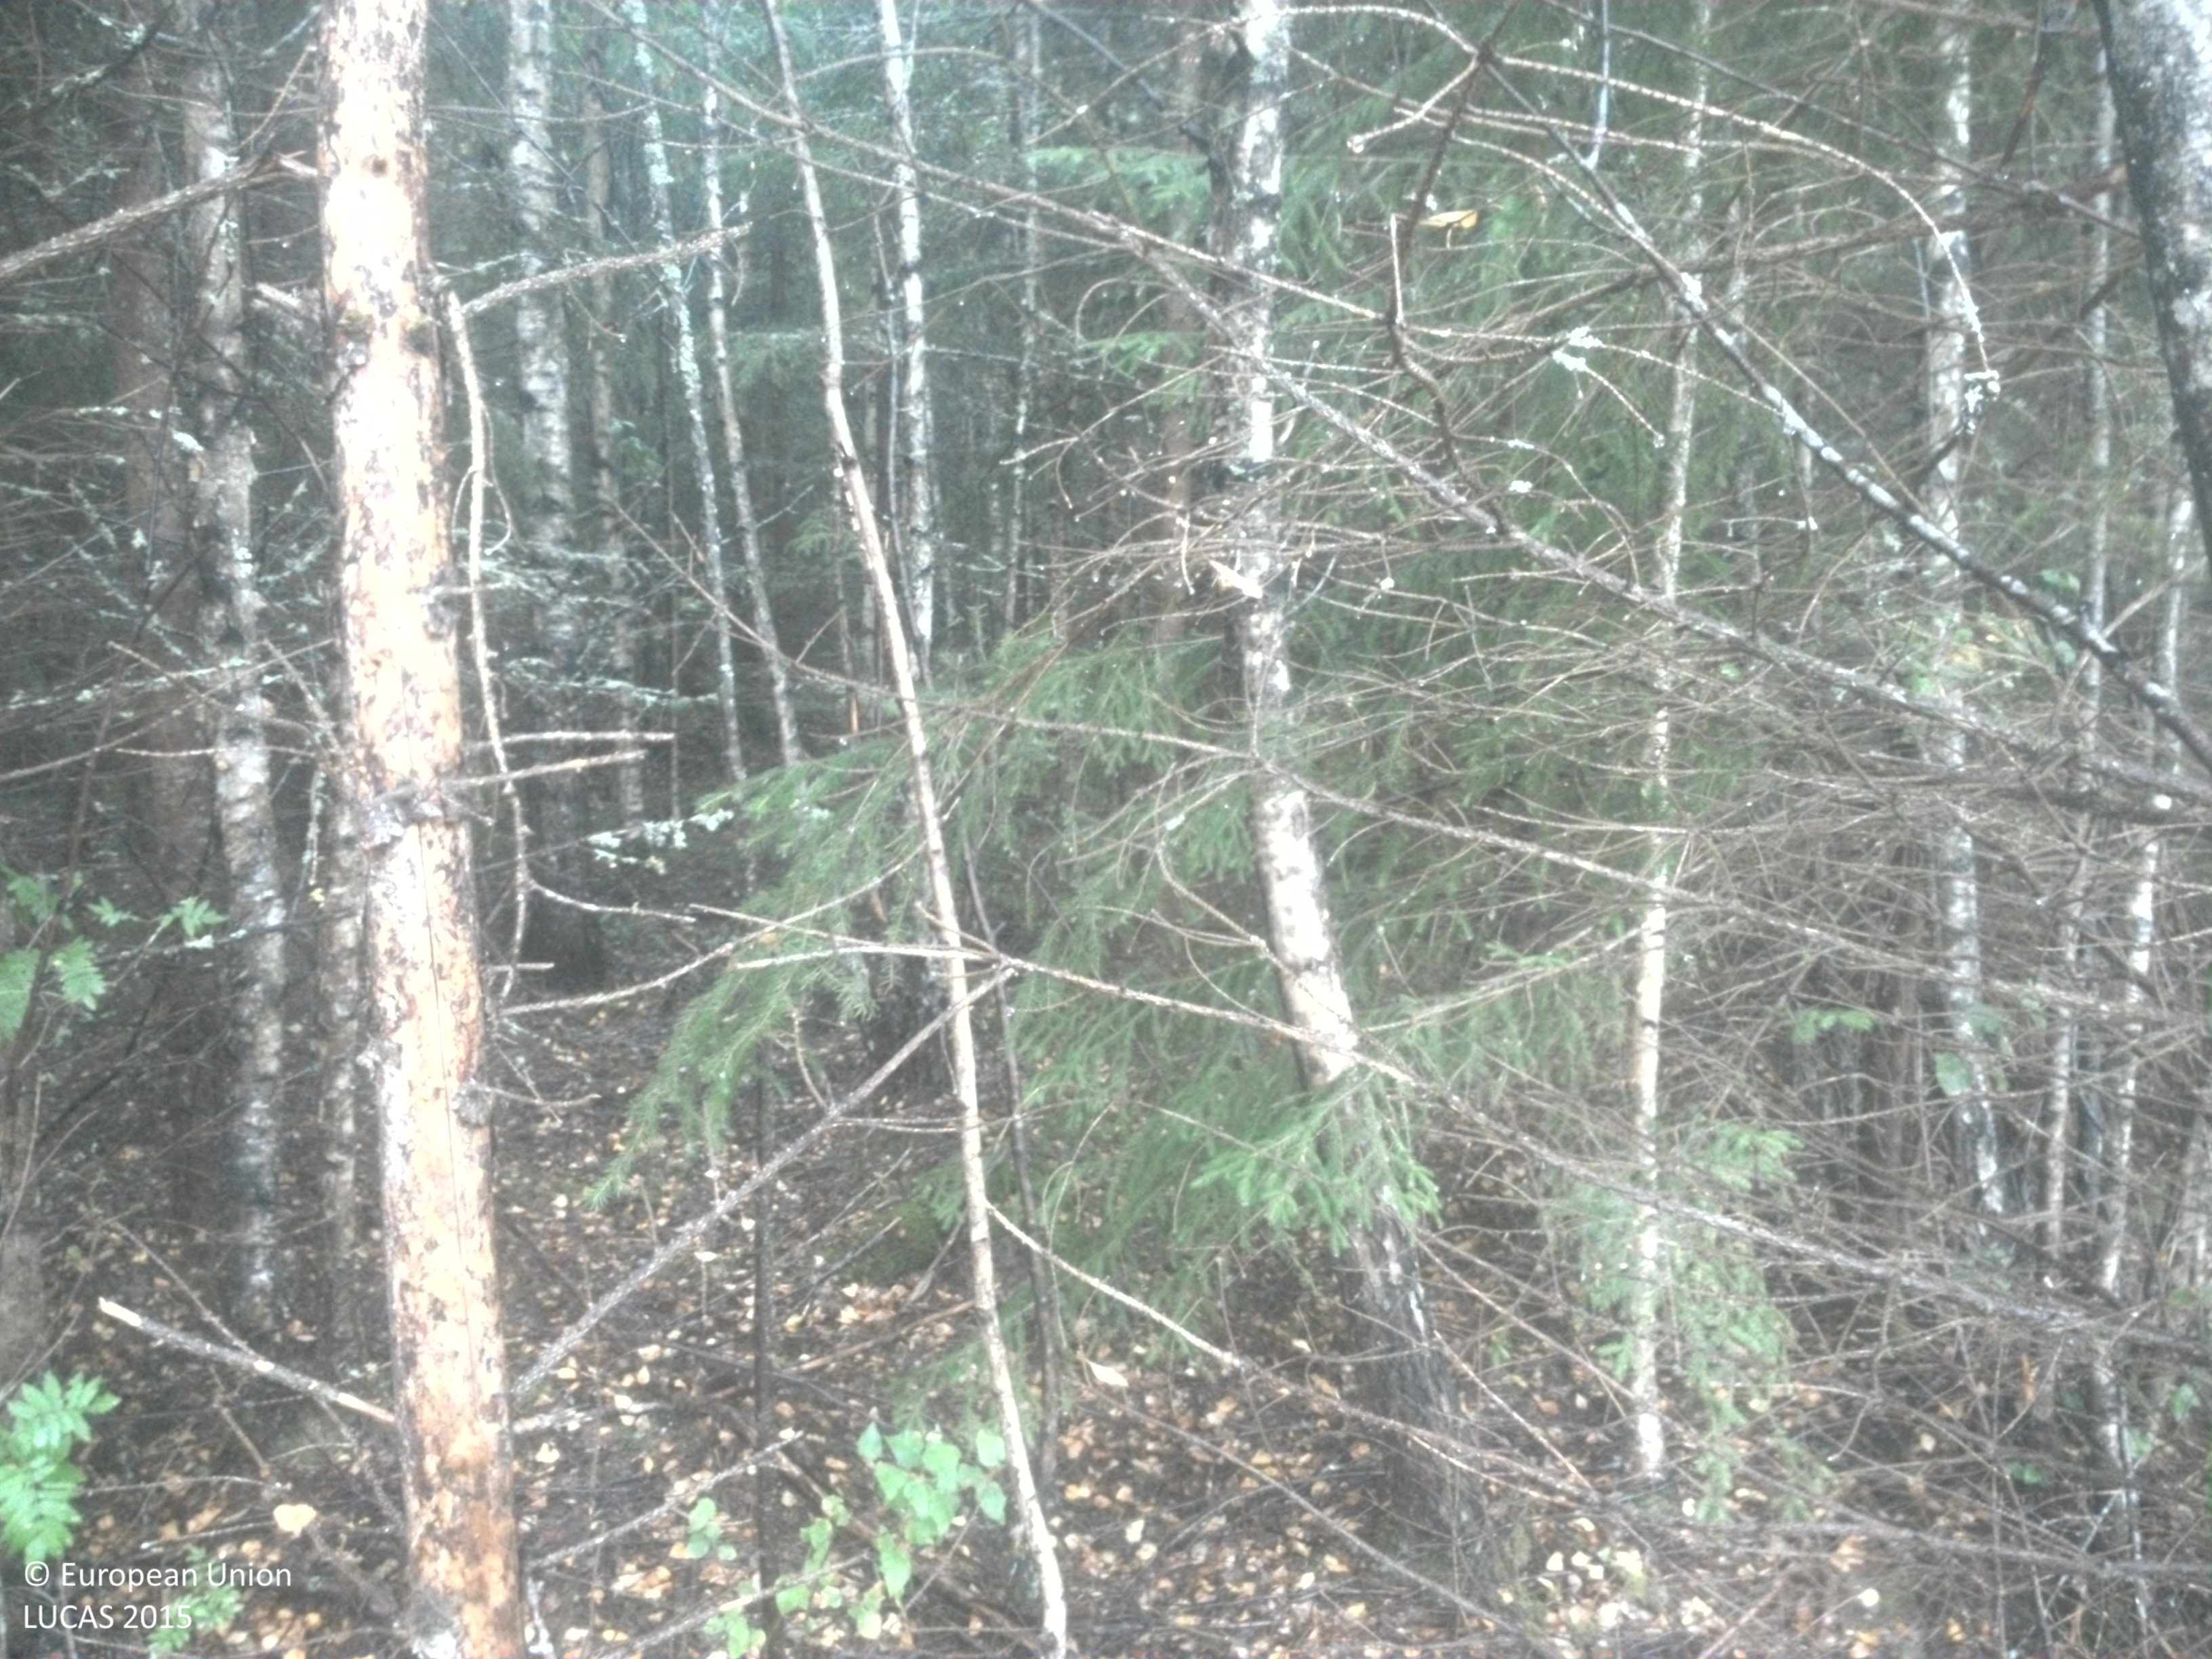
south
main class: Woodland
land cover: Spruce dominated mixed woodland
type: boreal forest
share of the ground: > 75 %
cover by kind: coniferous forest trees 55 %, broadleaved forest trees 30 %, lichens and mosses 5 %
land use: Forestry
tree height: > 5 m
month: August
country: SE
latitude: 59.6286
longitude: 15.7892
